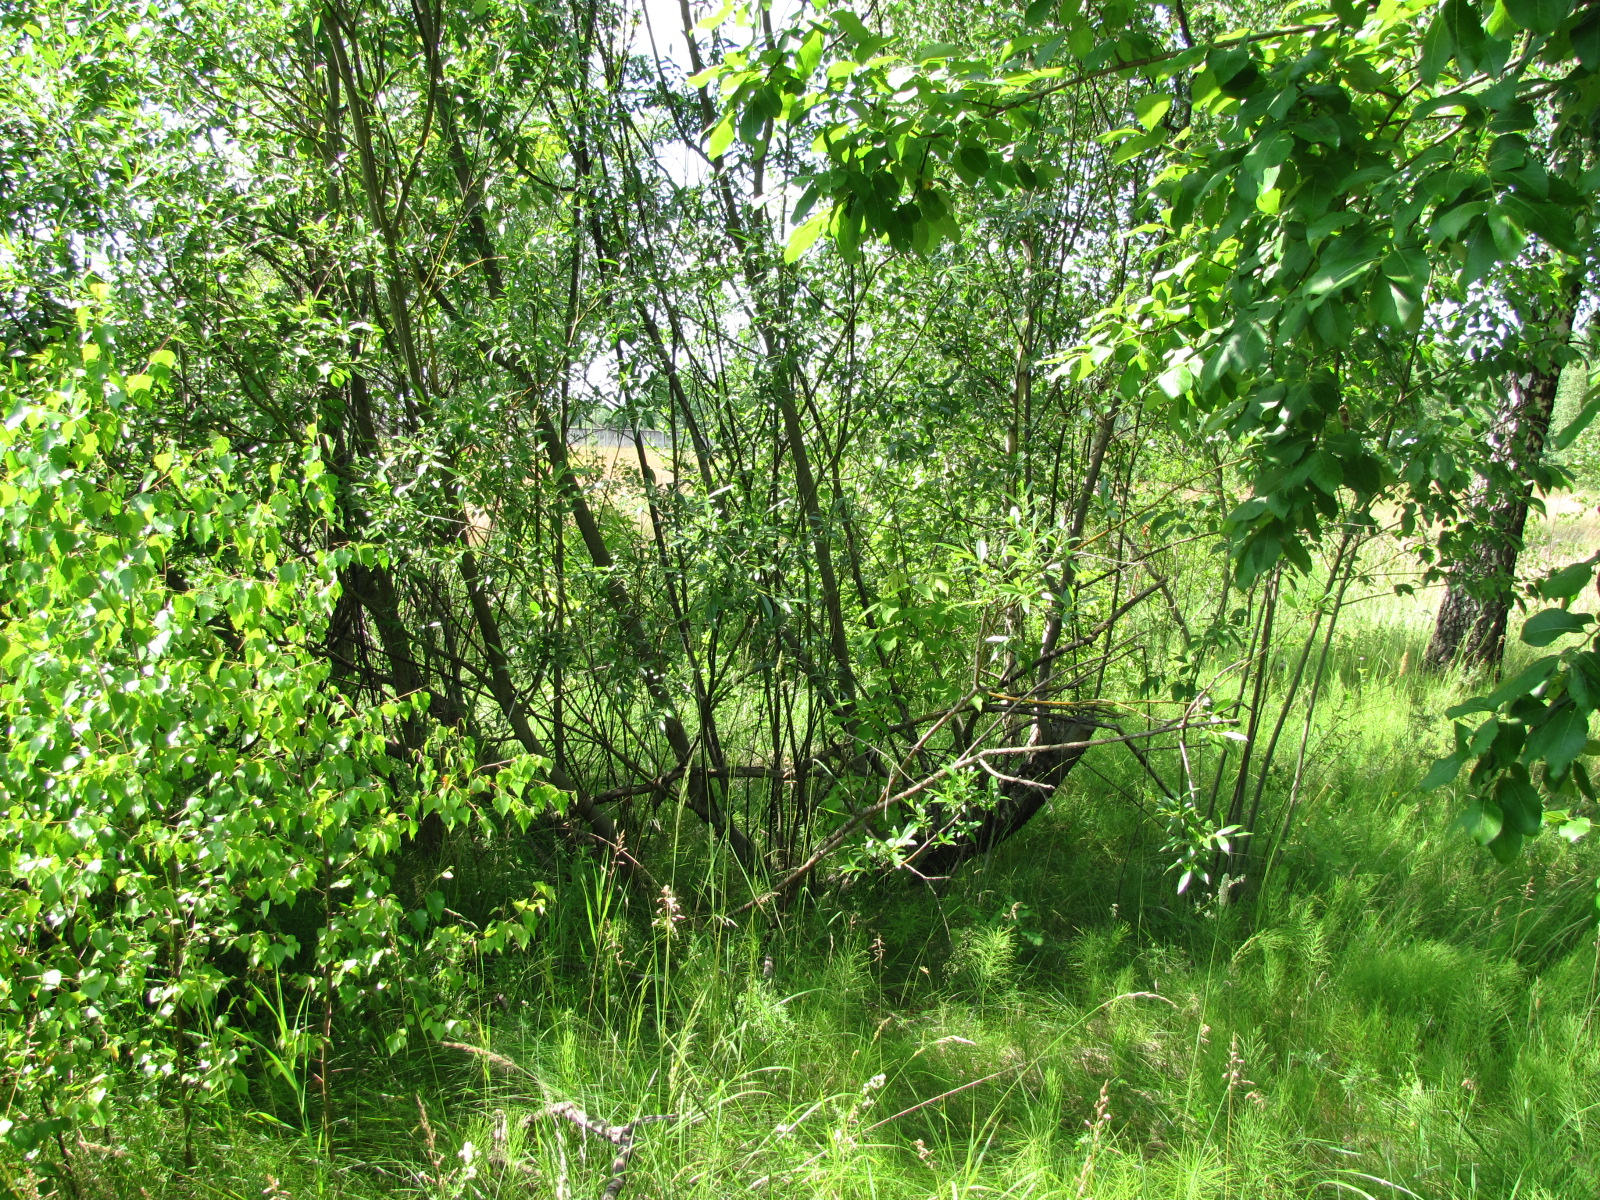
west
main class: Woodland
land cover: Broadleaved woodland
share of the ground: 50 - 75 %
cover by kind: broadleaved forest trees 60 %, herbaceous plants 40 %
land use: Amenities, museums, leisure
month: July
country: LV
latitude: 56.8903
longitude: 24.2208
